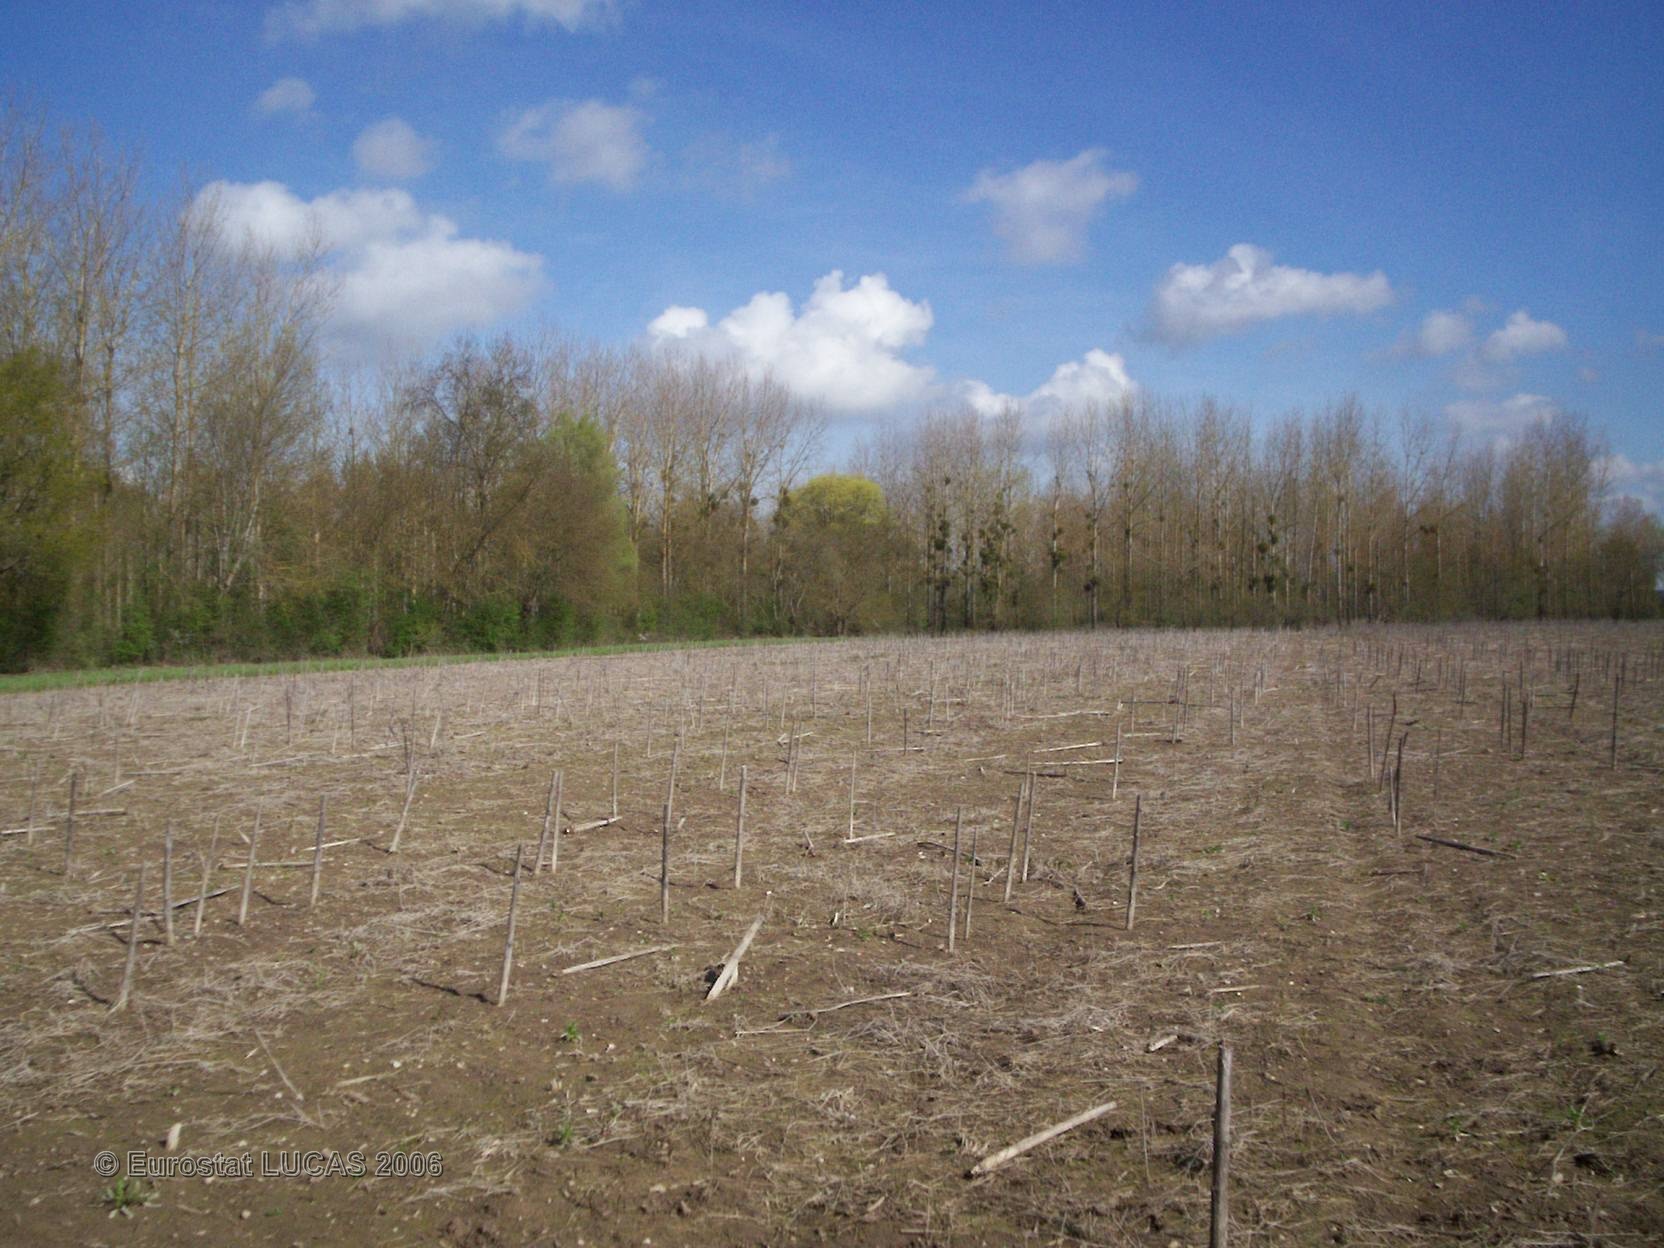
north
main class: Cropland
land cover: Maize
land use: Agriculture (excluding fallow land and kitchen gardens)
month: May
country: FR
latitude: 47.5634
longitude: -0.4376
